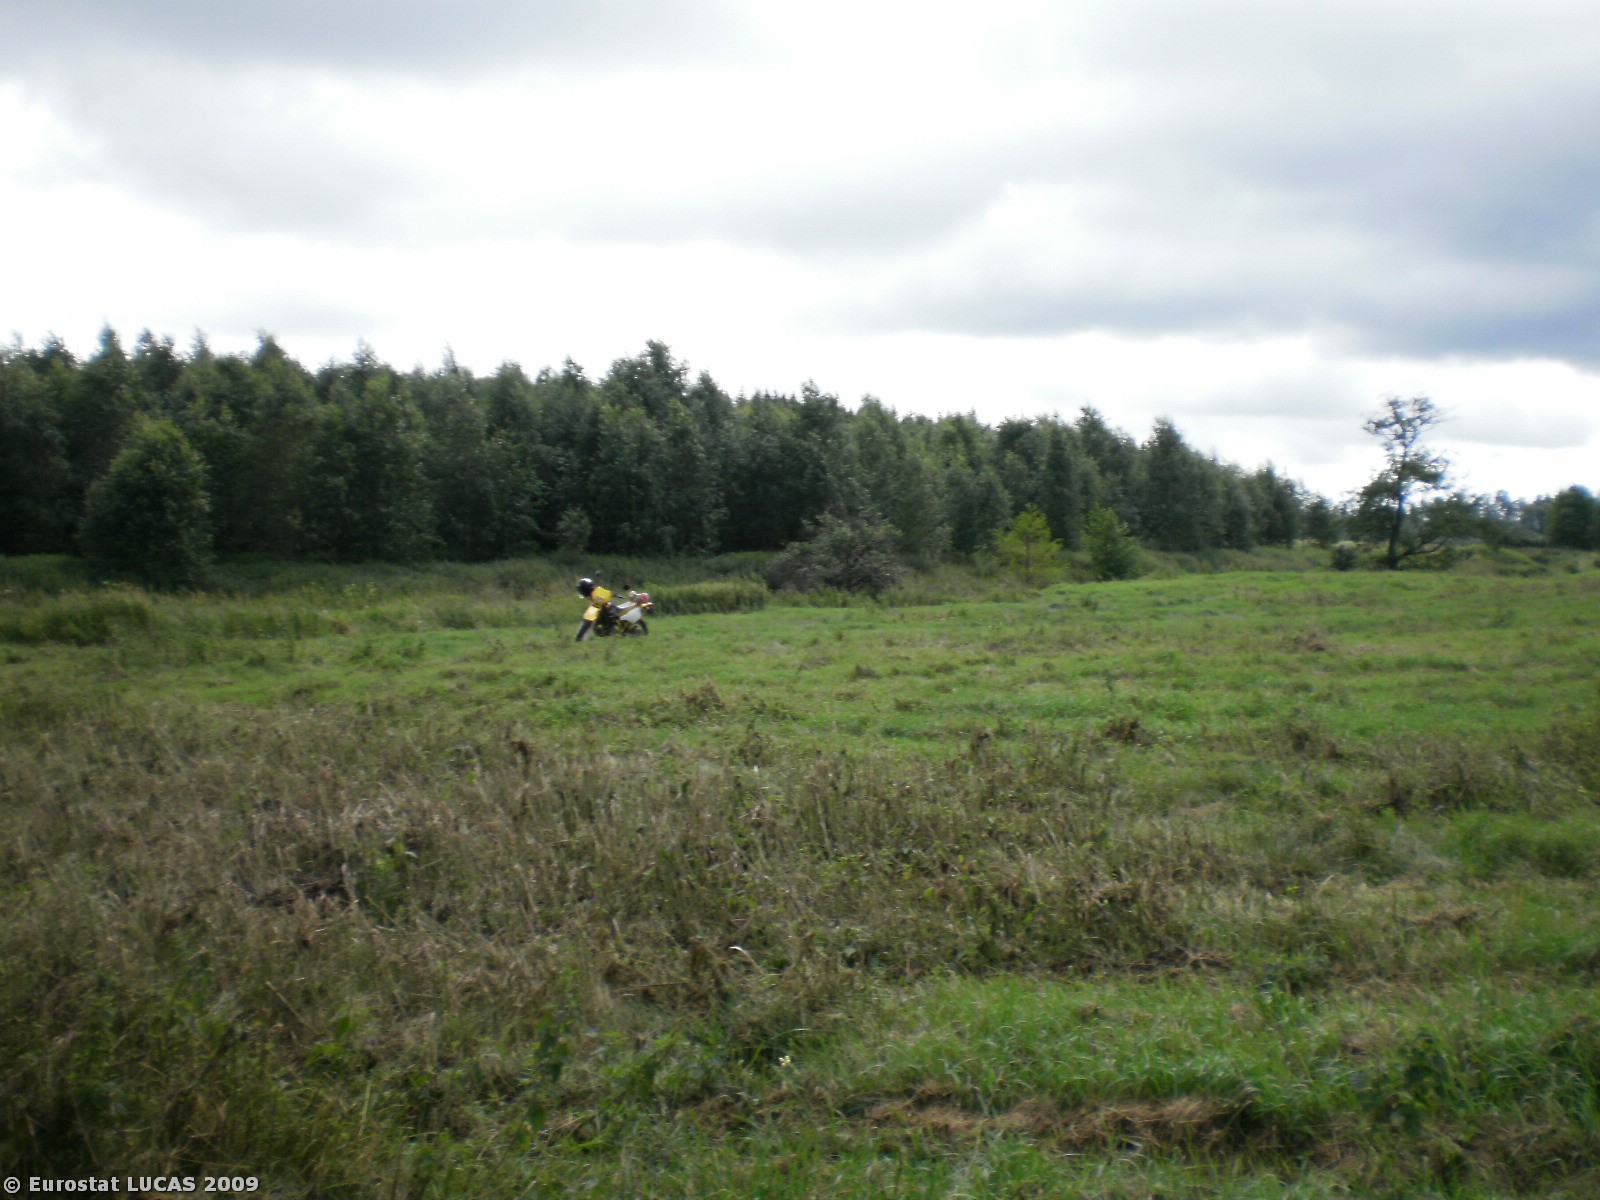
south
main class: Grassland
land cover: Grassland without tree/shrub cover
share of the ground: > 75 %
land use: Agriculture (excluding fallow land and kitchen gardens)
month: July
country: PL
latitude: 54.0276
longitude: 20.5552
